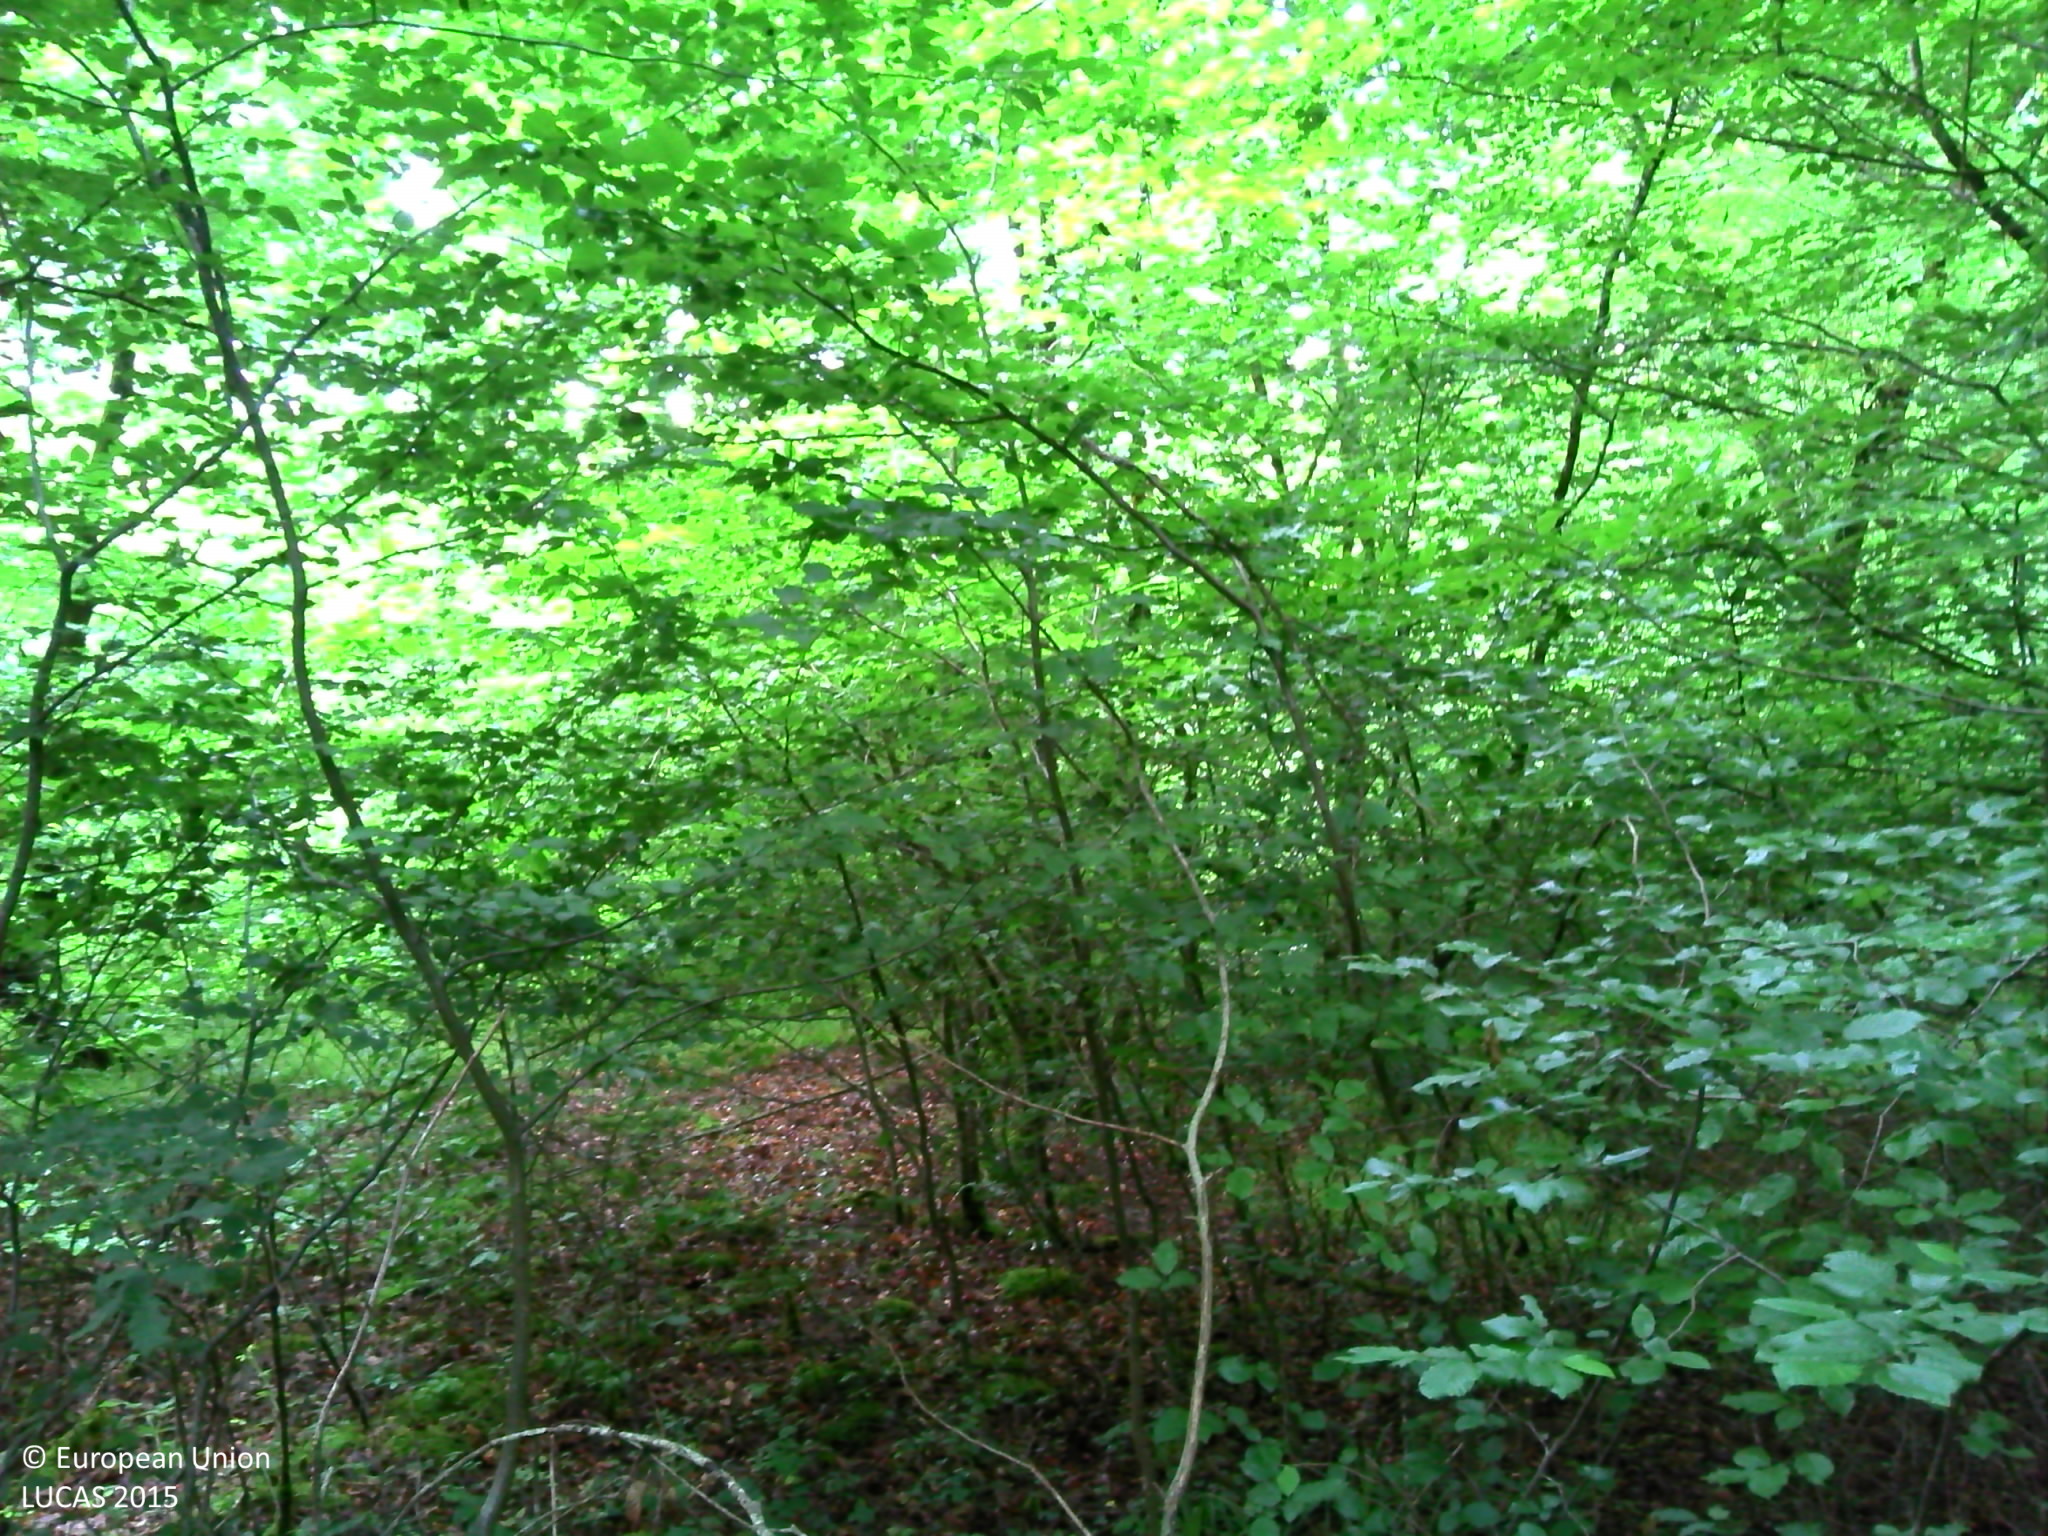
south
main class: Woodland
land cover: Broadleaved woodland
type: acidophilous oak and oak-birch forest
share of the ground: > 75 %
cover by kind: broadleaved forest trees 85 %, herbaceous plants 10 %, unconsolidated bare surface 5 %
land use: Forestry
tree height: > 5 m
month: June
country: FR
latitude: 46.5880
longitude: 2.6738
